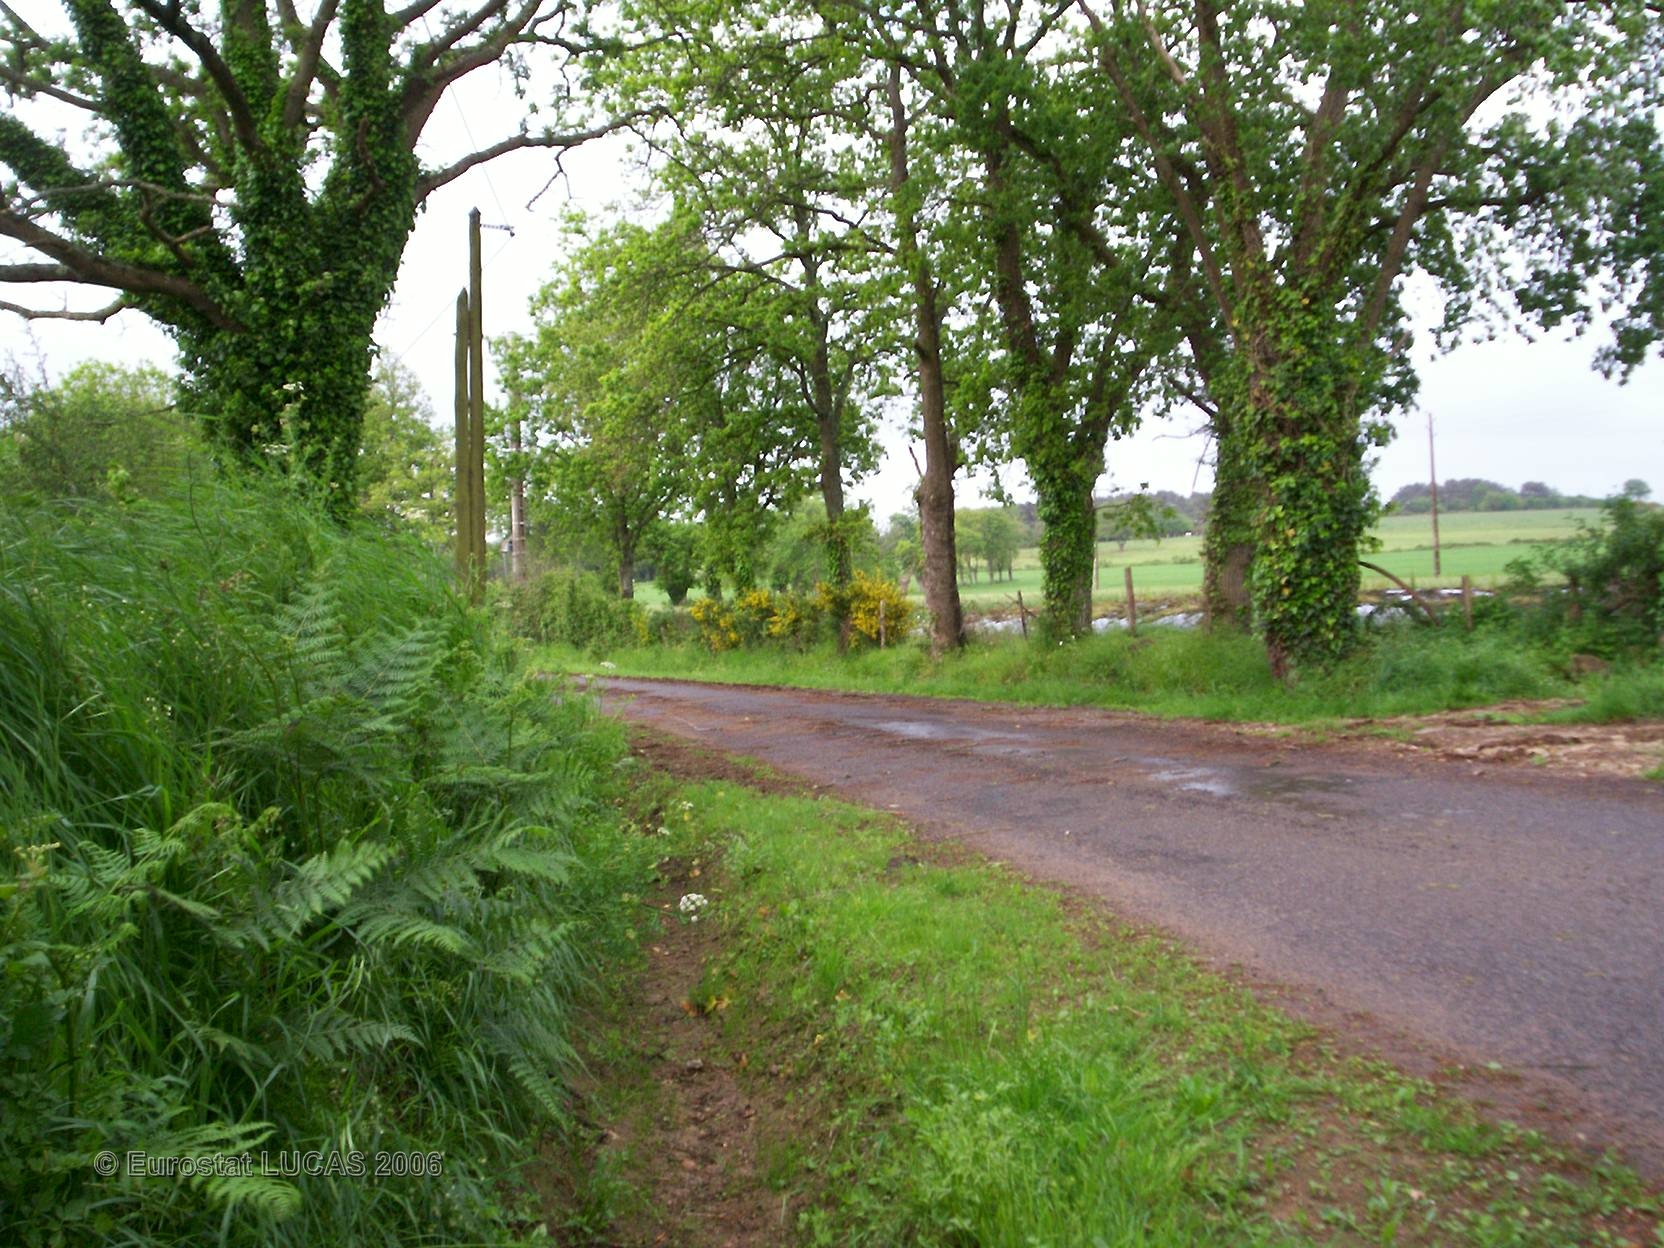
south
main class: Grassland
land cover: Grassland without tree/shrub cover
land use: Agriculture (excluding fallow land and kitchen gardens)
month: May
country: FR
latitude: 47.4799
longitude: -2.2753
